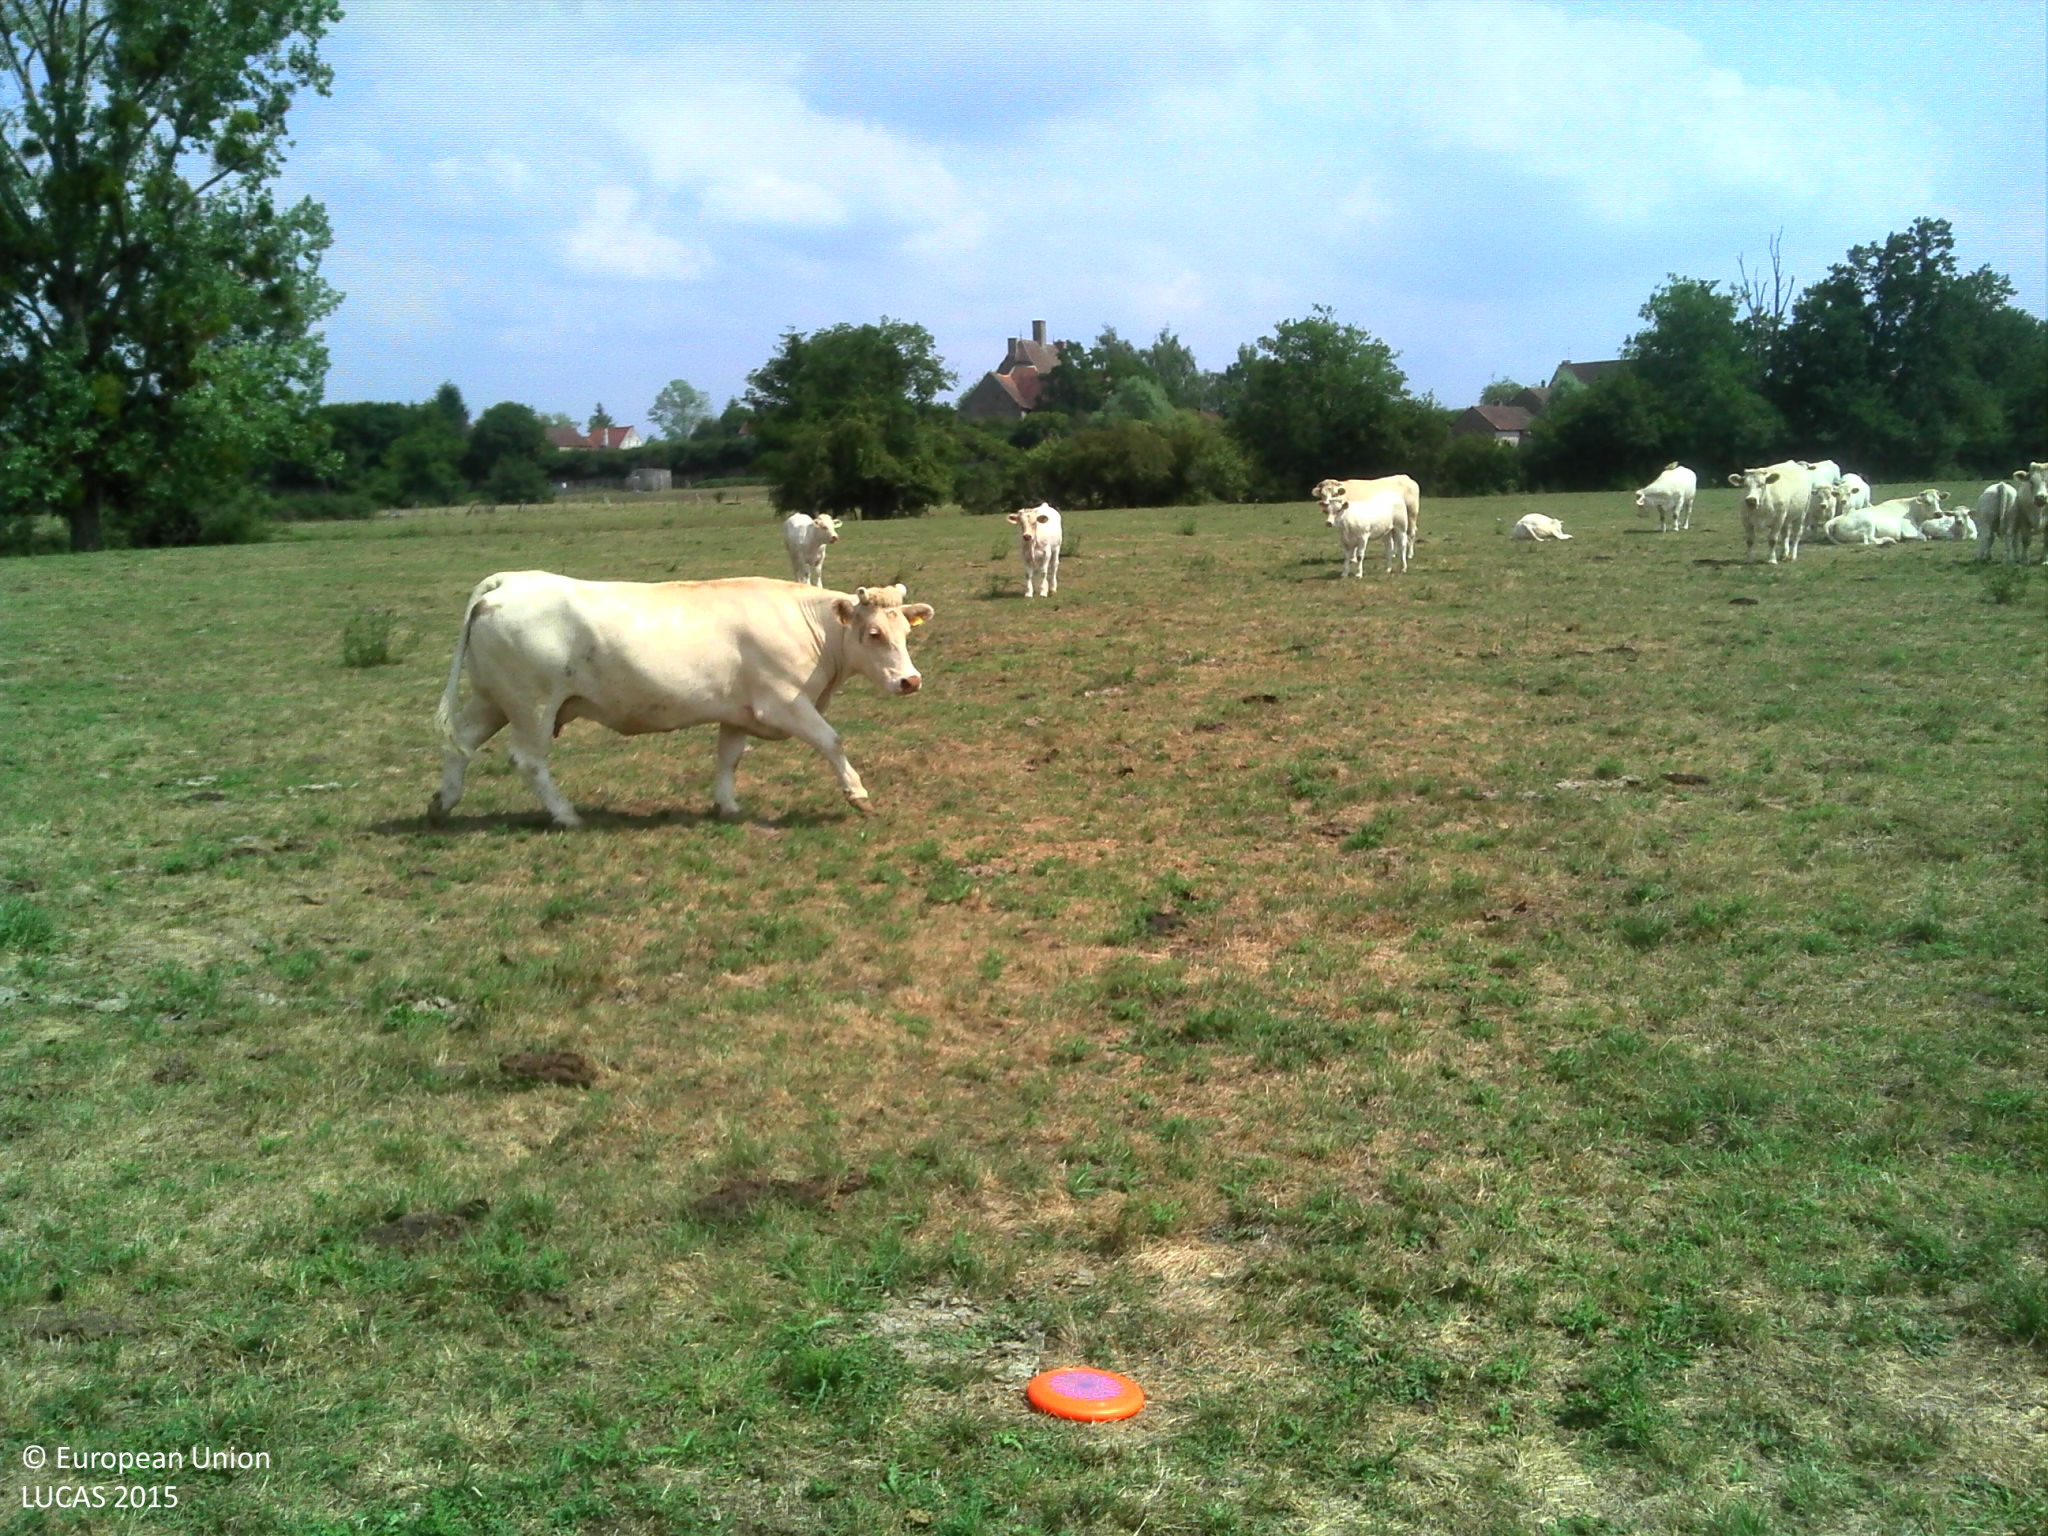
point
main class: Grassland
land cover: Grassland without tree/shrub cover
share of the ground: > 75 %
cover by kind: herbaceous plants 100 %
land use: Agriculture (excluding fallow land and kitchen gardens)
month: August
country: FR
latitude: 47.0131
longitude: 4.3302
